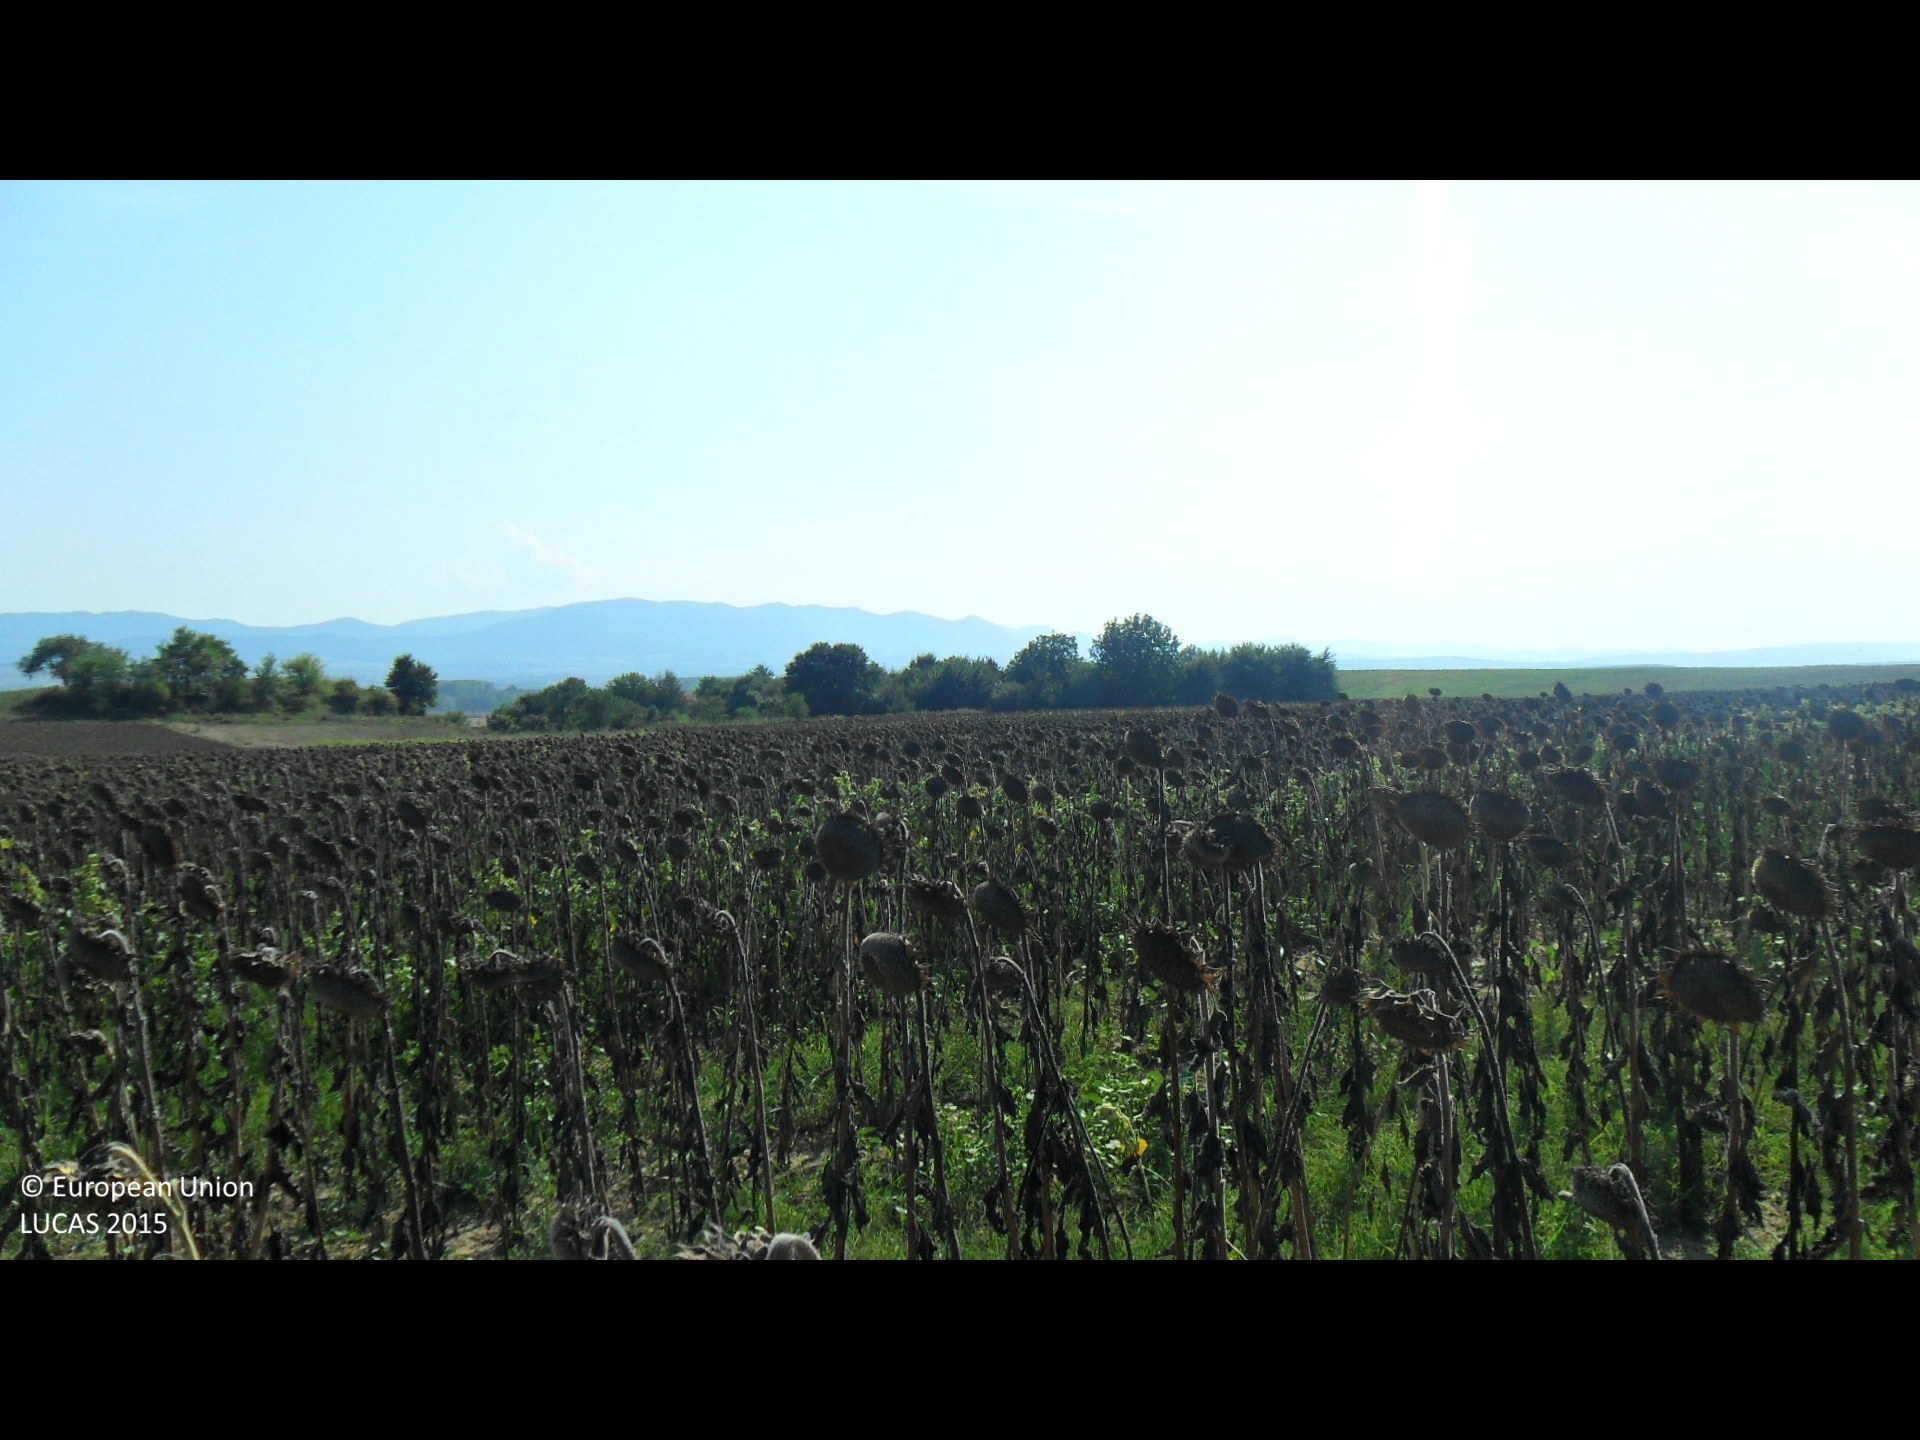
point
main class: Cropland
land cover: Sunflower
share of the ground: > 75 %
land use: Agriculture (excluding fallow land and kitchen gardens)
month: September
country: BG
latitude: 43.0643
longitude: 26.6687
